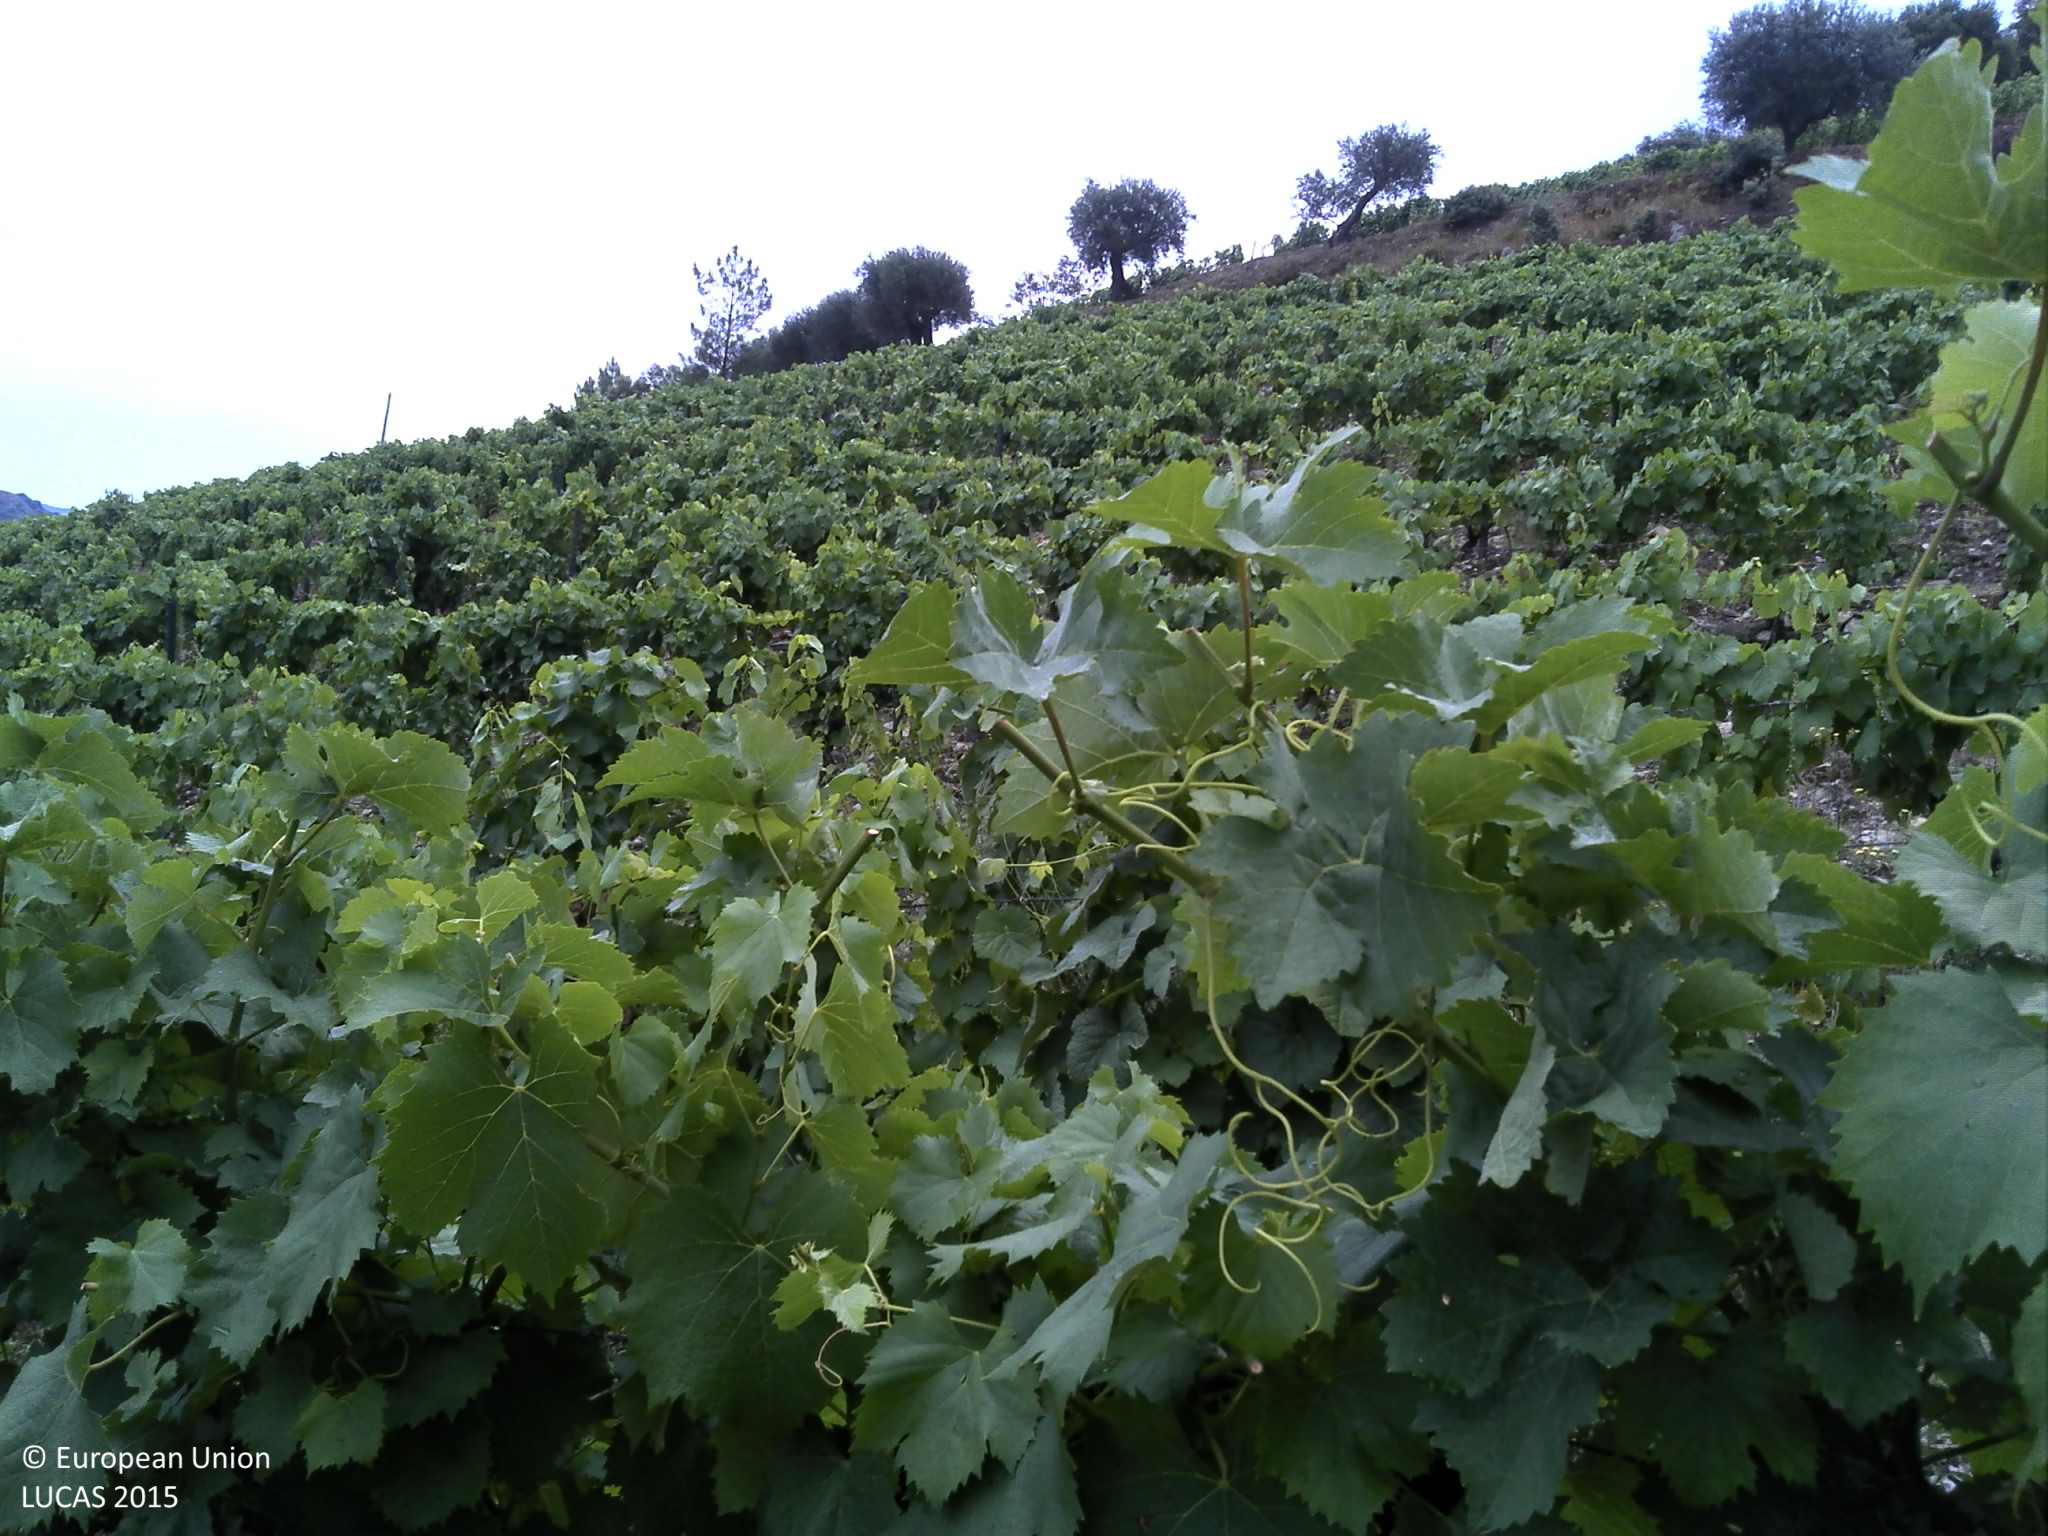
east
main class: Cropland
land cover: Vineyards
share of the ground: 10 - 25 %
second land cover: Spontaneously vegetated surfaces
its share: 50 - 75 %
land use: Agriculture (excluding fallow land and kitchen gardens)
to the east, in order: Vineyards; Spontaneously vegetated surfaces; Tracks; Vineyards; Tracks; Spontaneously vegetated surfaces; Abandoned hedges; Vineyards; Shrubland with sparse tree cover; Dry stone walls; Shrubland with sparse tree cover; Tracks; Abandoned hedges; Olive groves; Tracks; Olive groves; Electric lines; Olive groves
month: June
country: PT
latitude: 41.2037
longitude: -7.4242
